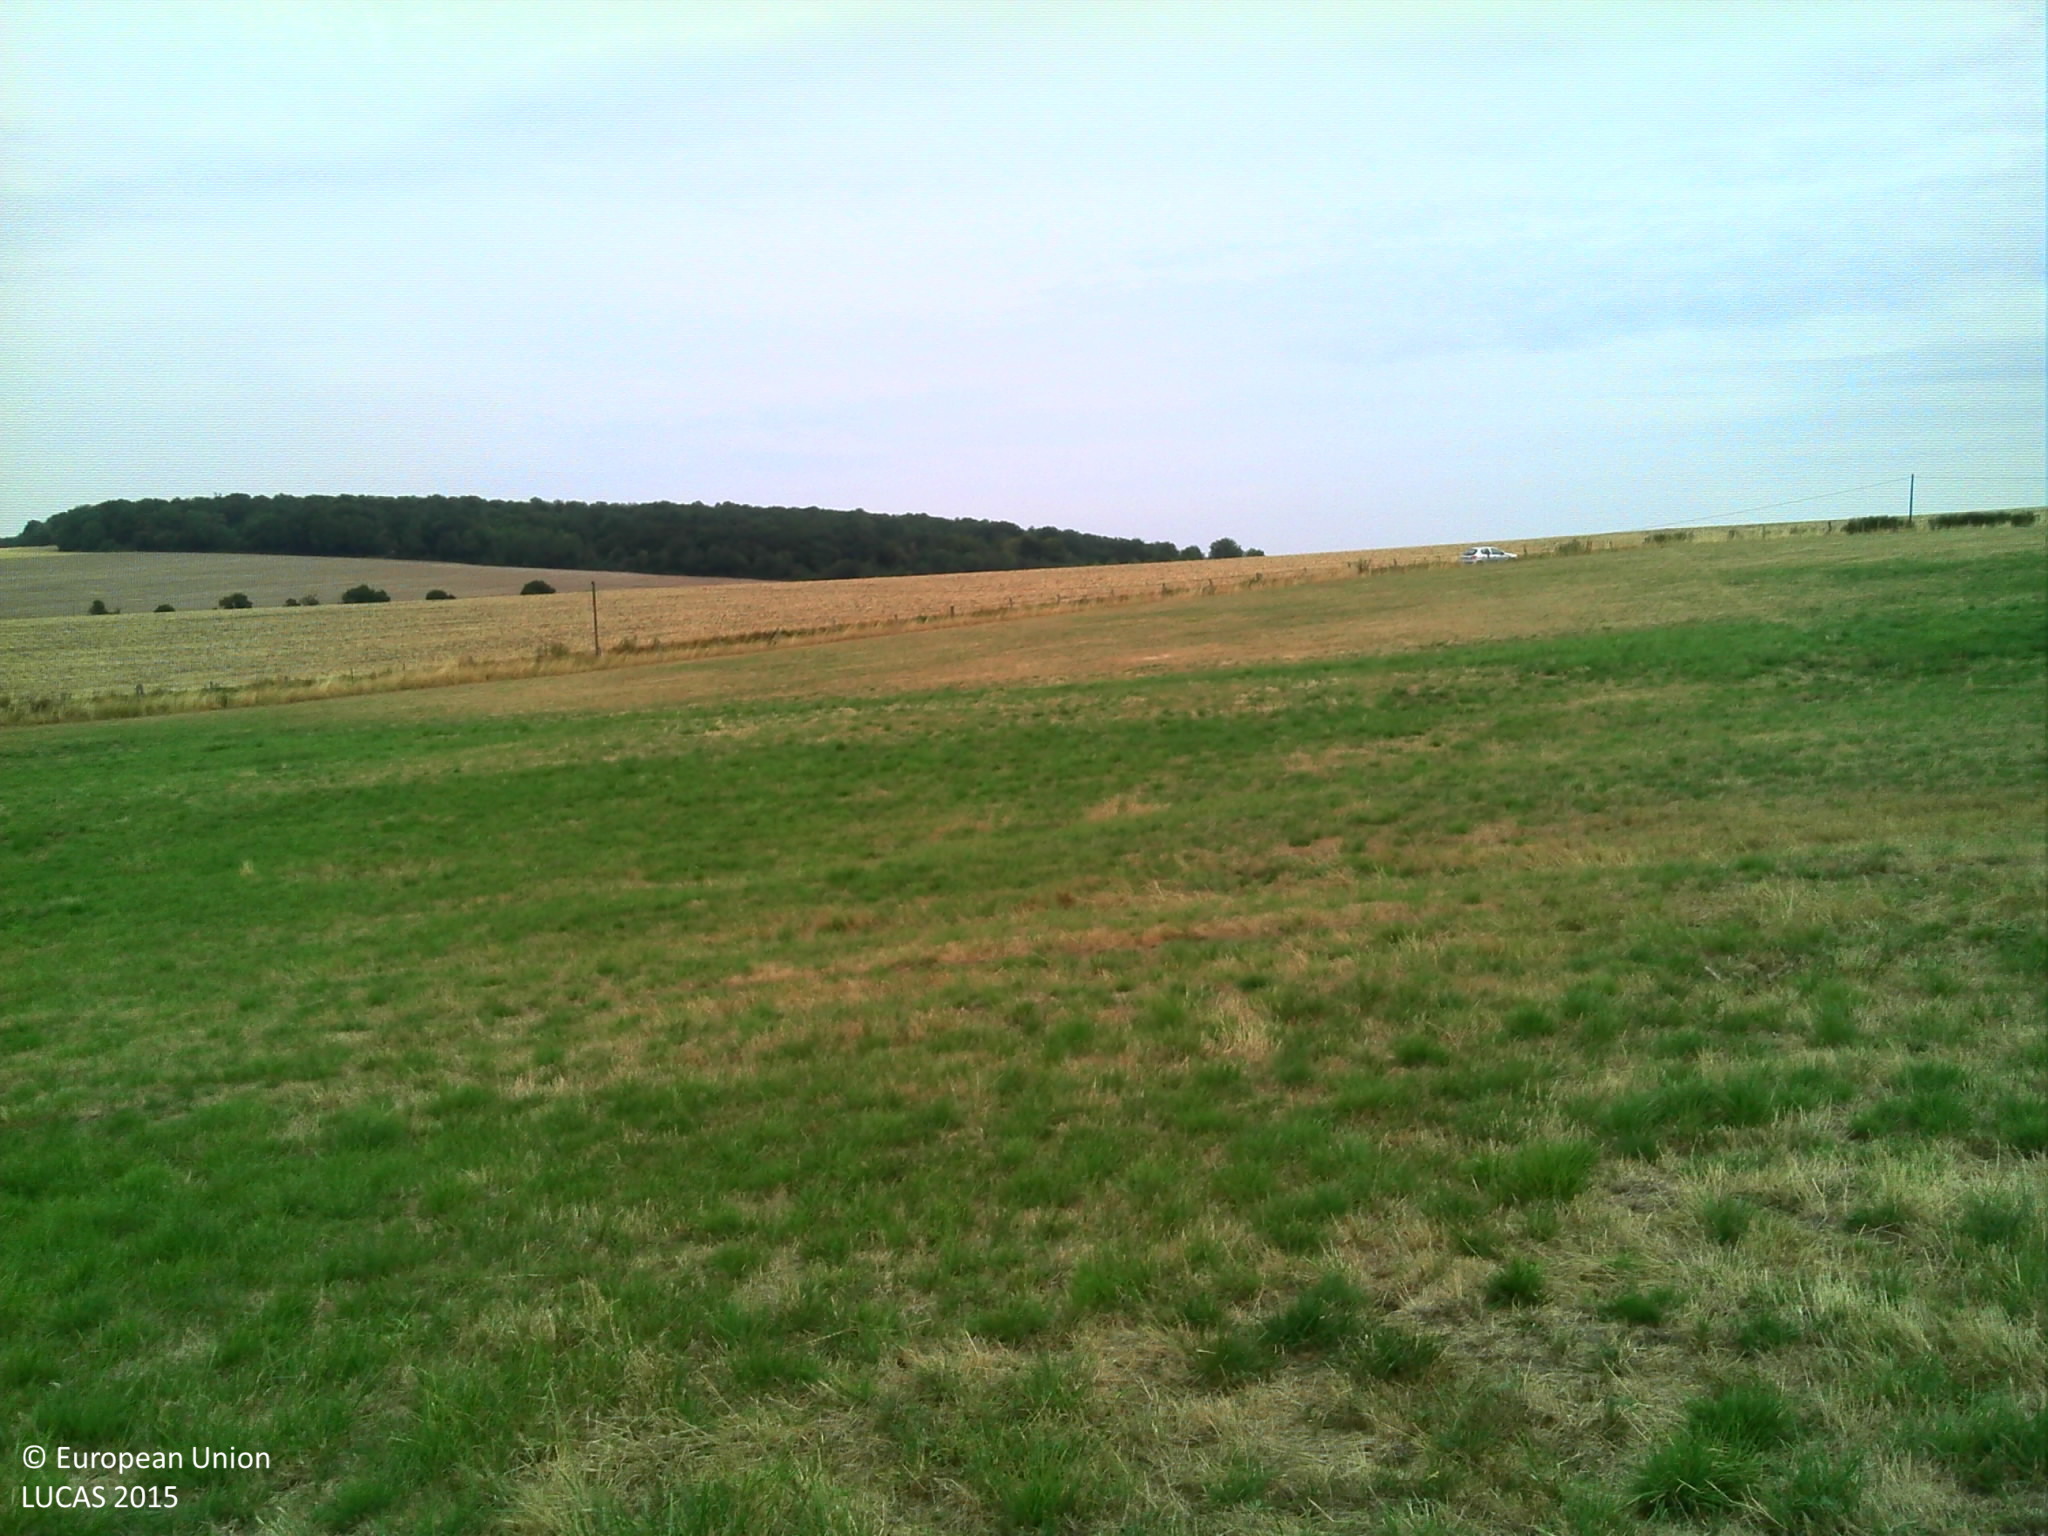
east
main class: Grassland
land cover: Grassland without tree/shrub cover
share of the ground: > 75 %
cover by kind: herbaceous plants 90 %, unconsolidated bare surface 5 %
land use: Agriculture (excluding fallow land and kitchen gardens)
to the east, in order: Grassland without tree/shrub cover; Fences; Electric lines; Ditches and canals; Grass margins; Paved roads, cycling and walking lanes; Grass margins; Ditches and canals; Other bare soil
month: August
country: FR
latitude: 49.2143
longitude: 3.6651
